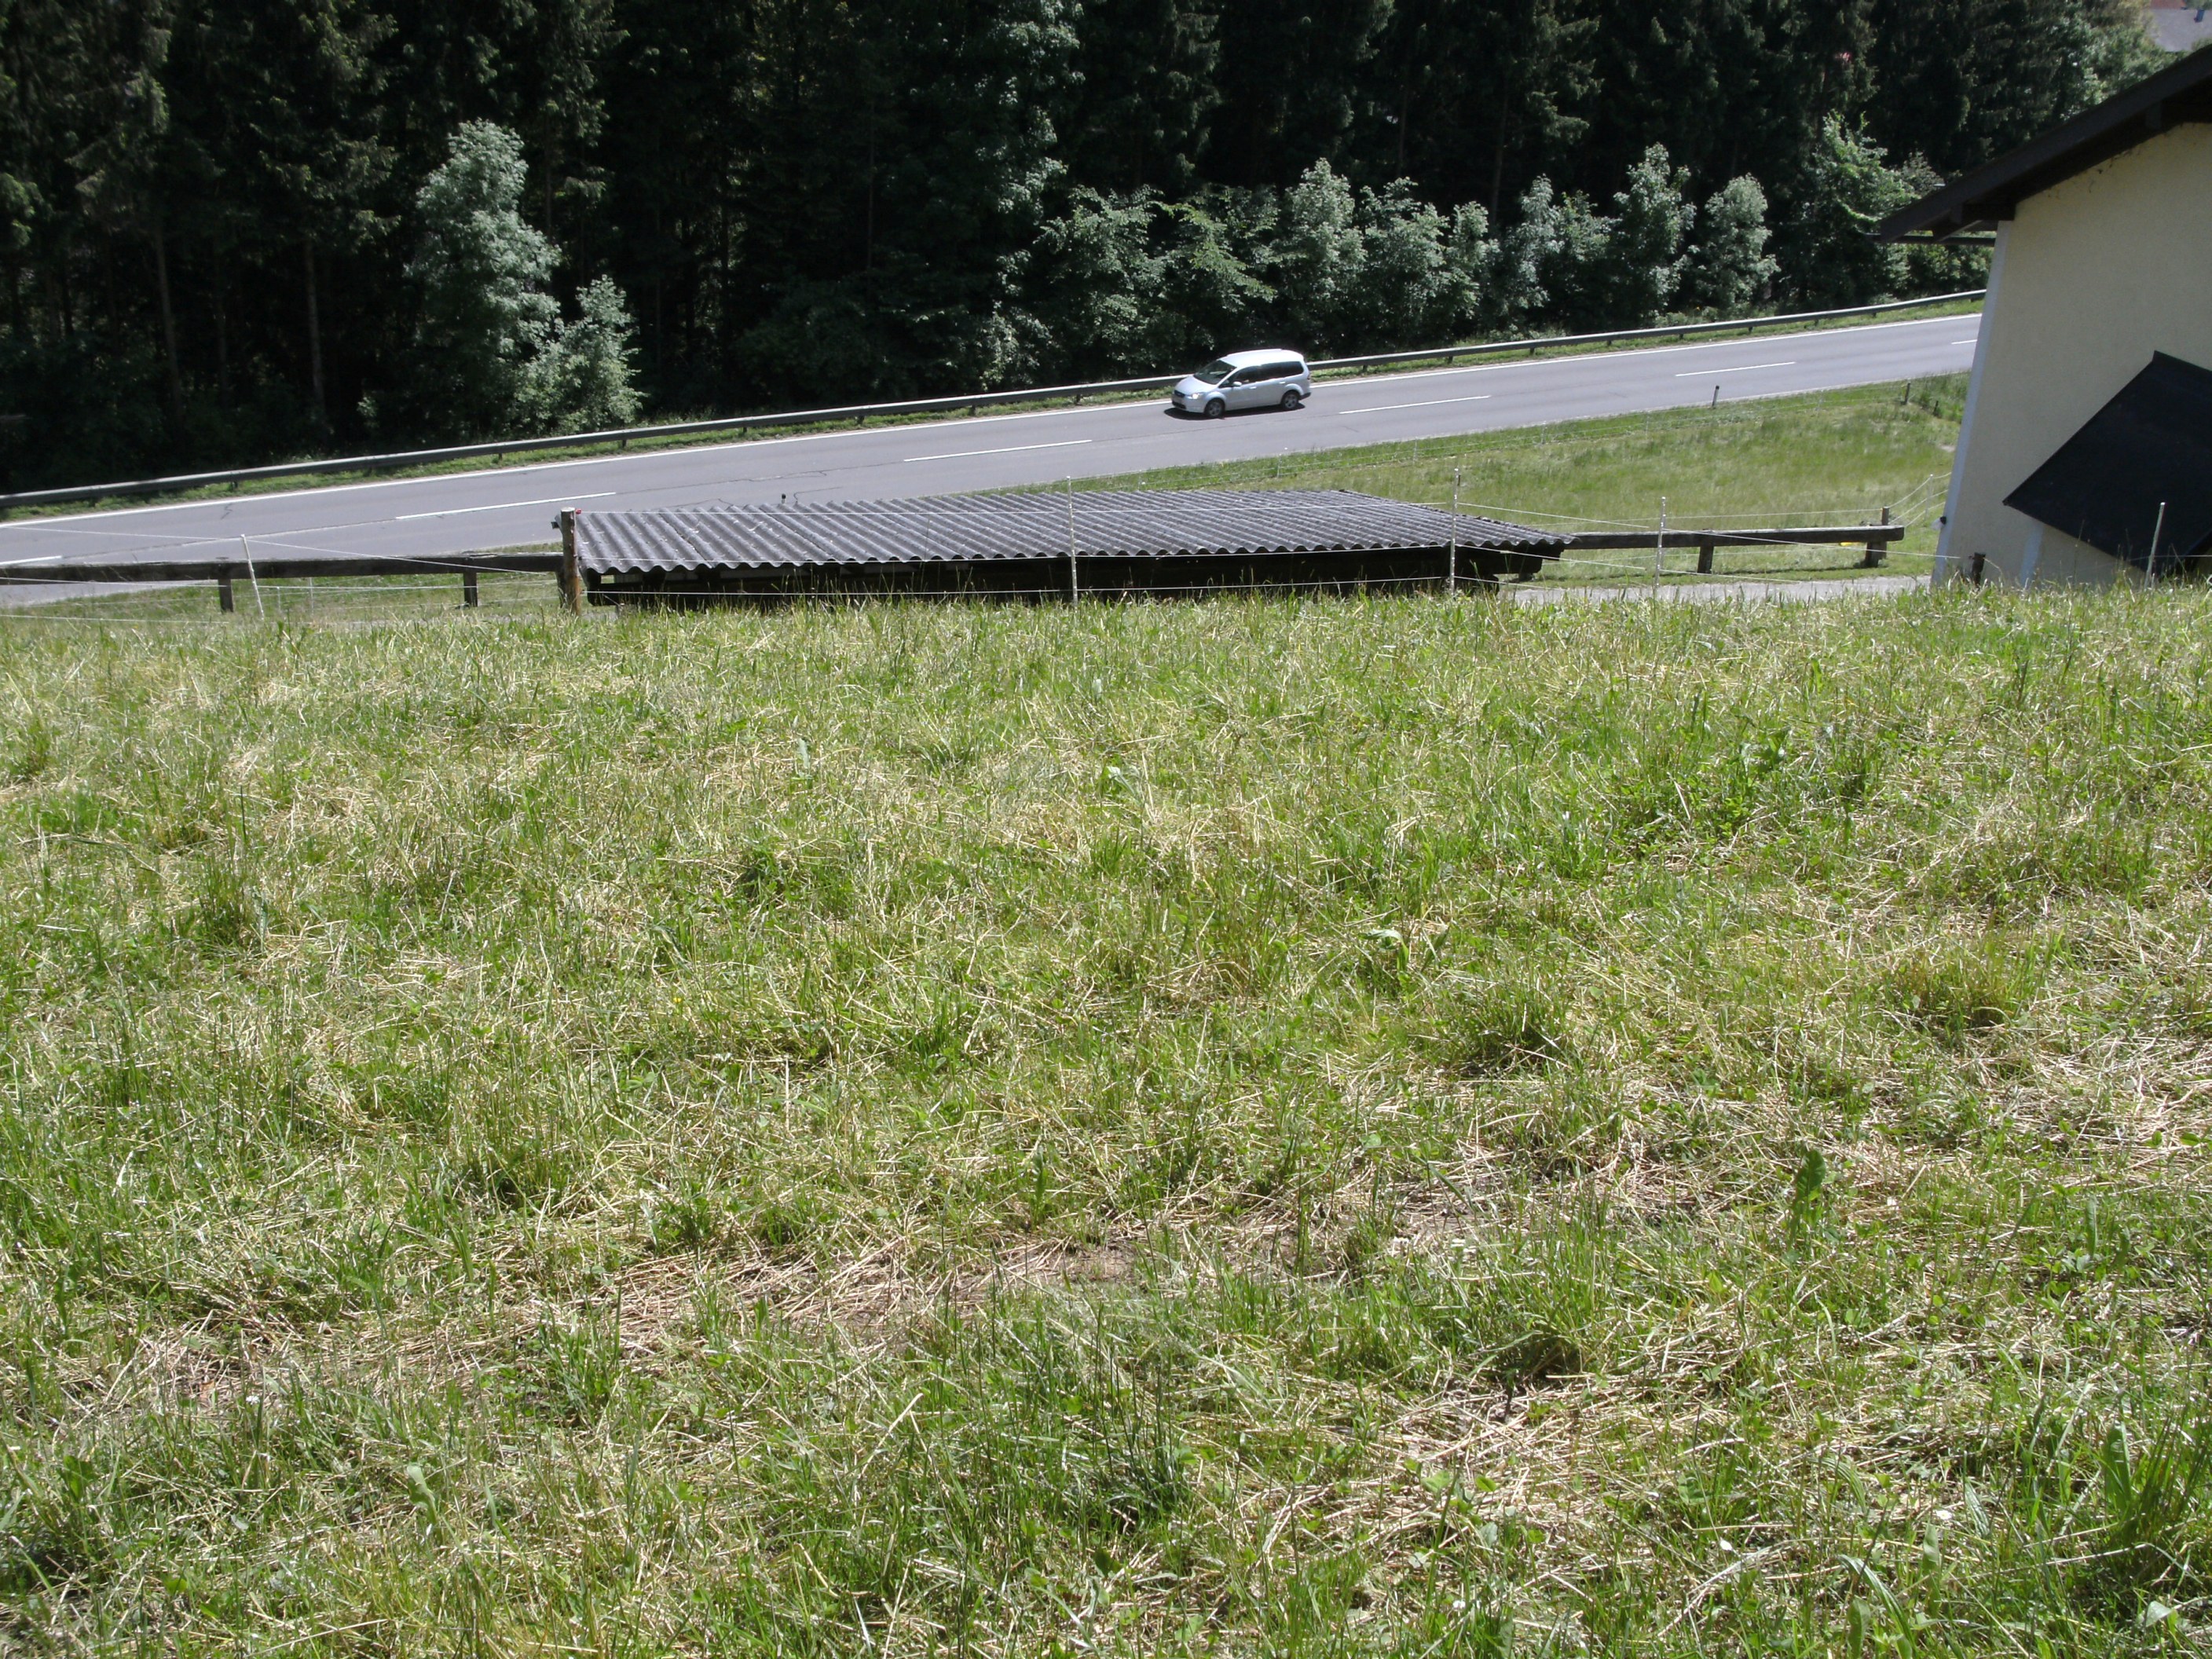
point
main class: Grassland
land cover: Grassland without tree/shrub cover
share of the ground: > 75 %
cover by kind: herbaceous plants 100 %
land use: Agriculture (excluding fallow land and kitchen gardens)
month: May
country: AT
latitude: 48.0240
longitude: 13.4987
